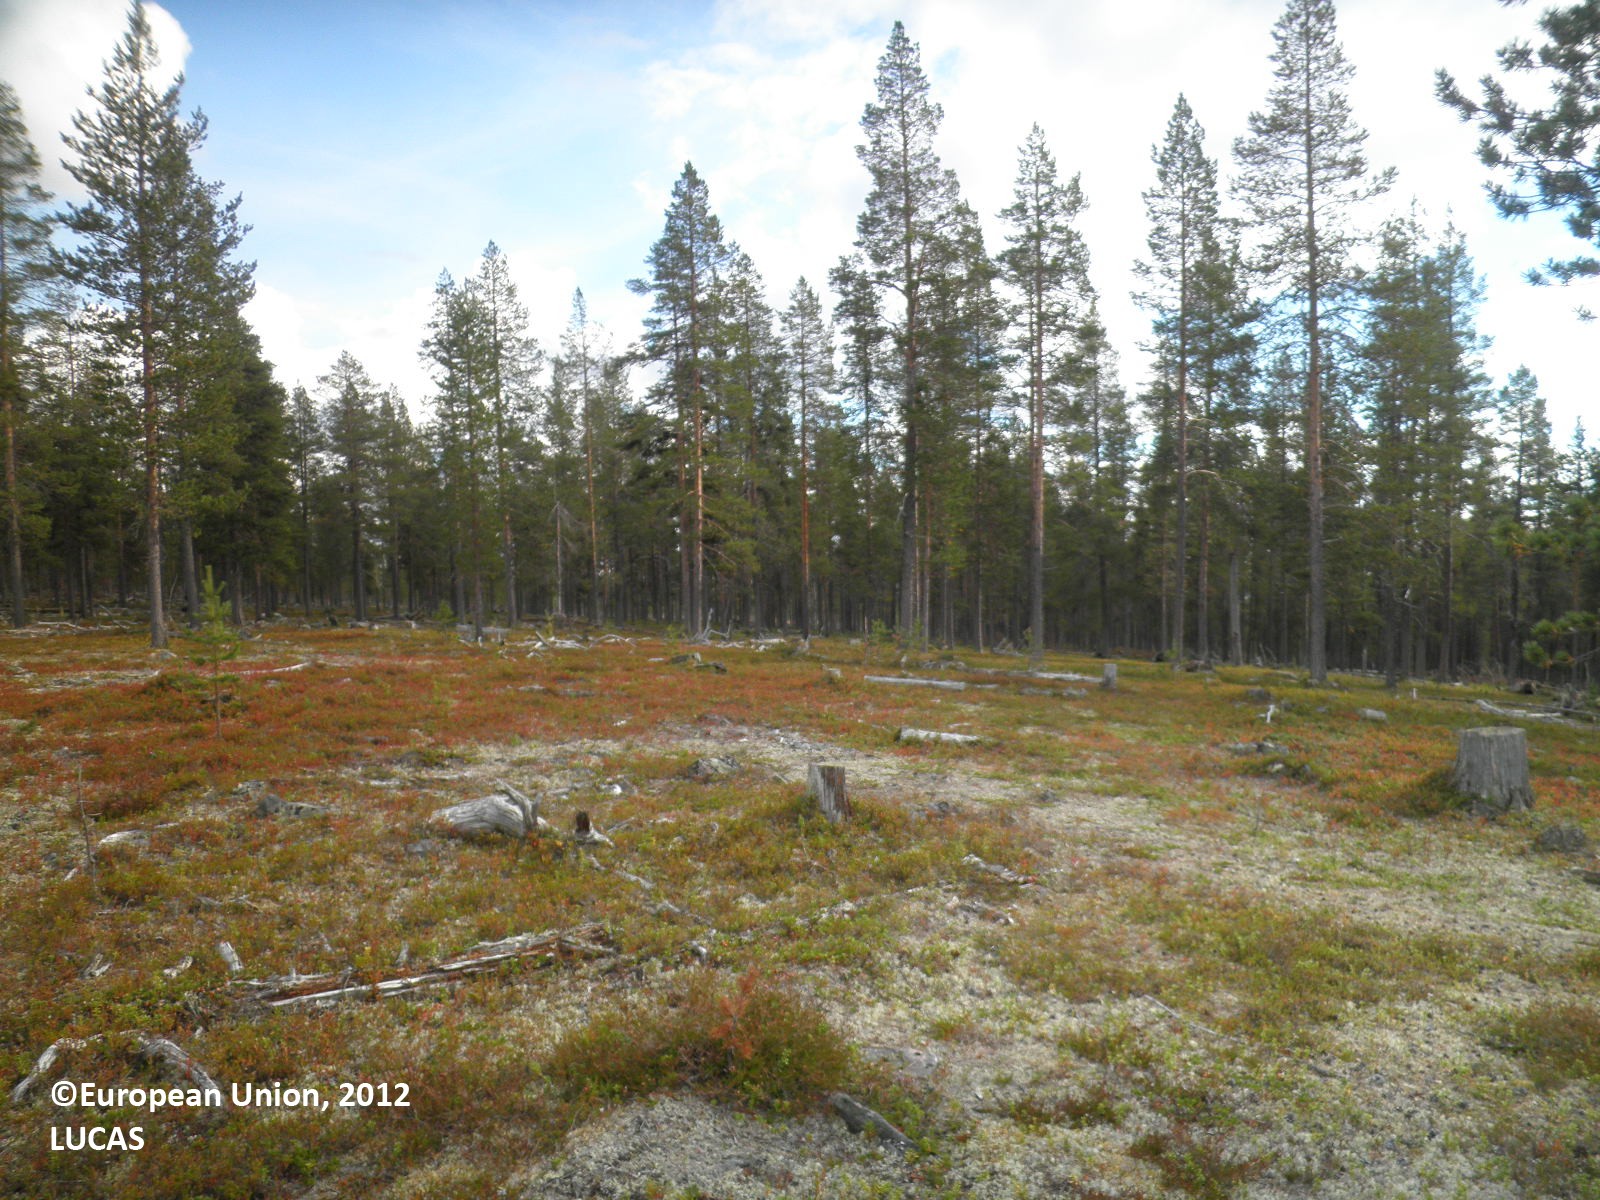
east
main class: Shrubland
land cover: Shrubland with sparse tree cover
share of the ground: > 75 %
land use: Forestry
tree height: > 5 m
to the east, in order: Shrubland with sparse tree cover; Pine dominated coniferous woodland
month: August
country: FI
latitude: 68.0224
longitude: 28.2360
